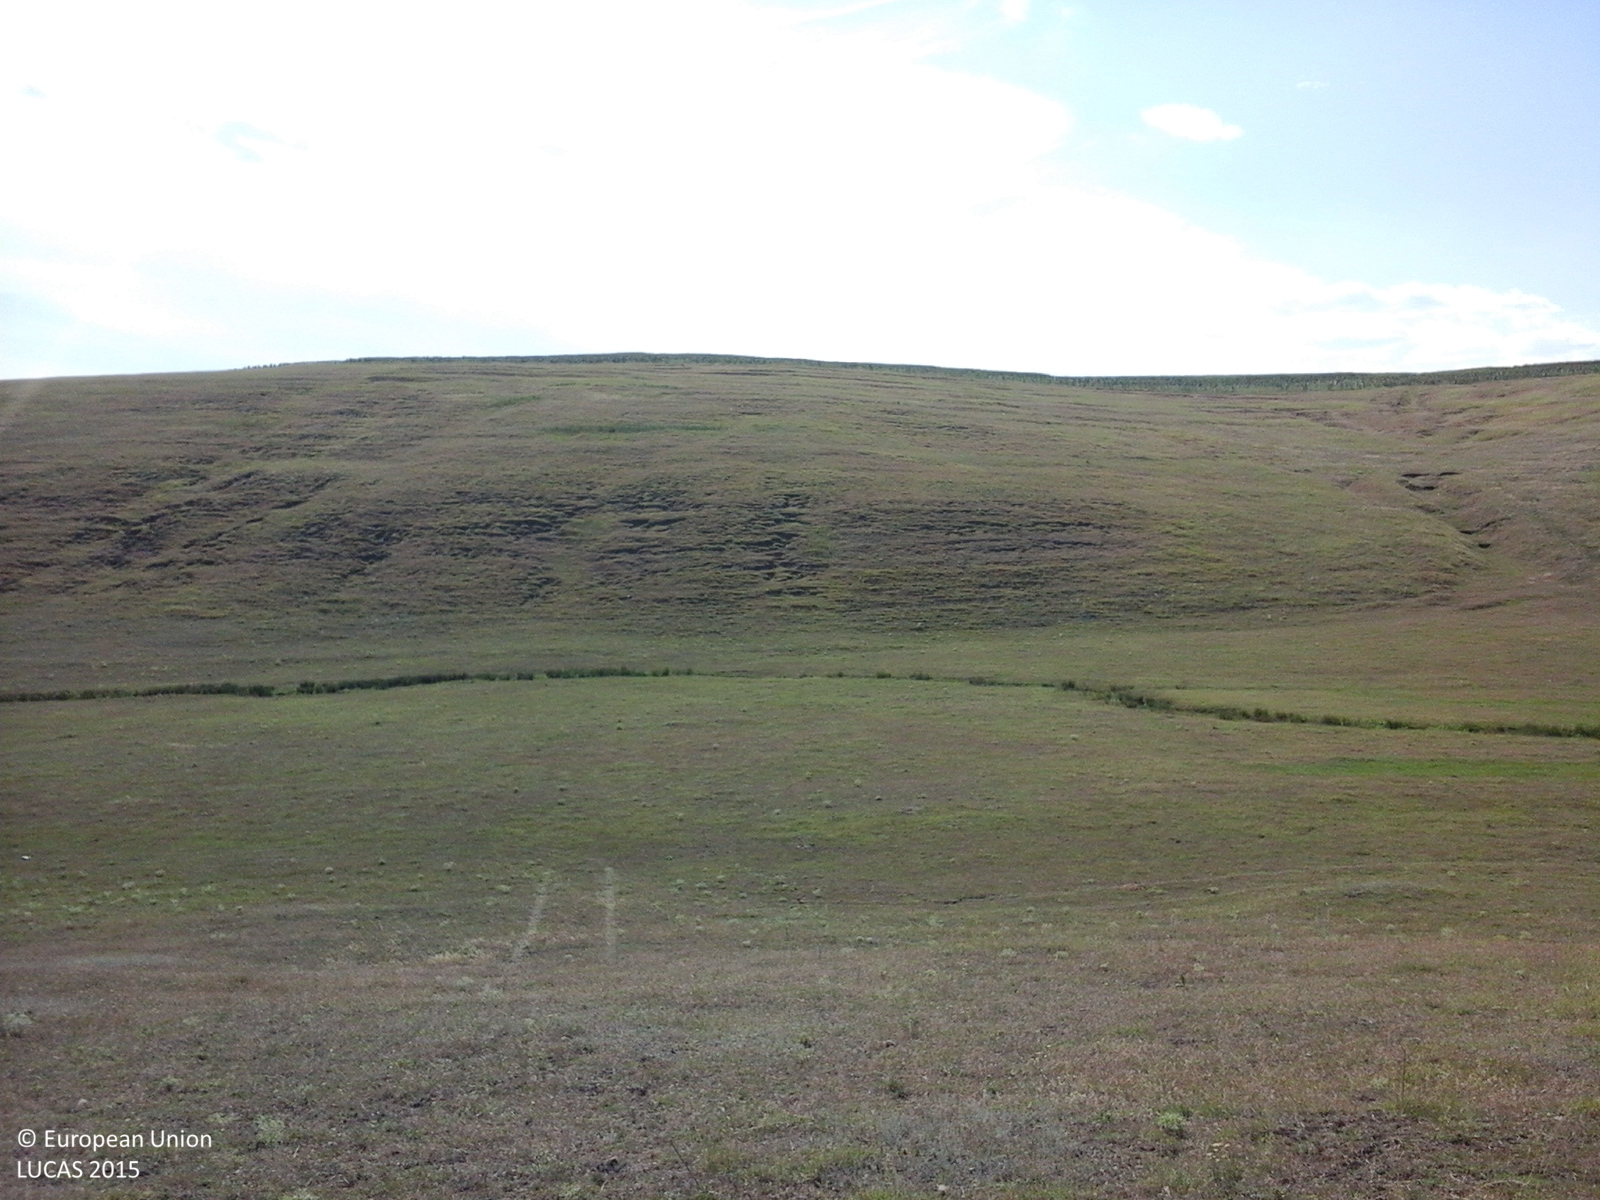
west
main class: Grassland
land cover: Grassland without tree/shrub cover
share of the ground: > 75 %
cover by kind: herbaceous plants 100 %
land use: Agriculture (excluding fallow land and kitchen gardens)
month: July
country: RO
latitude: 46.0258
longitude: 27.6682
